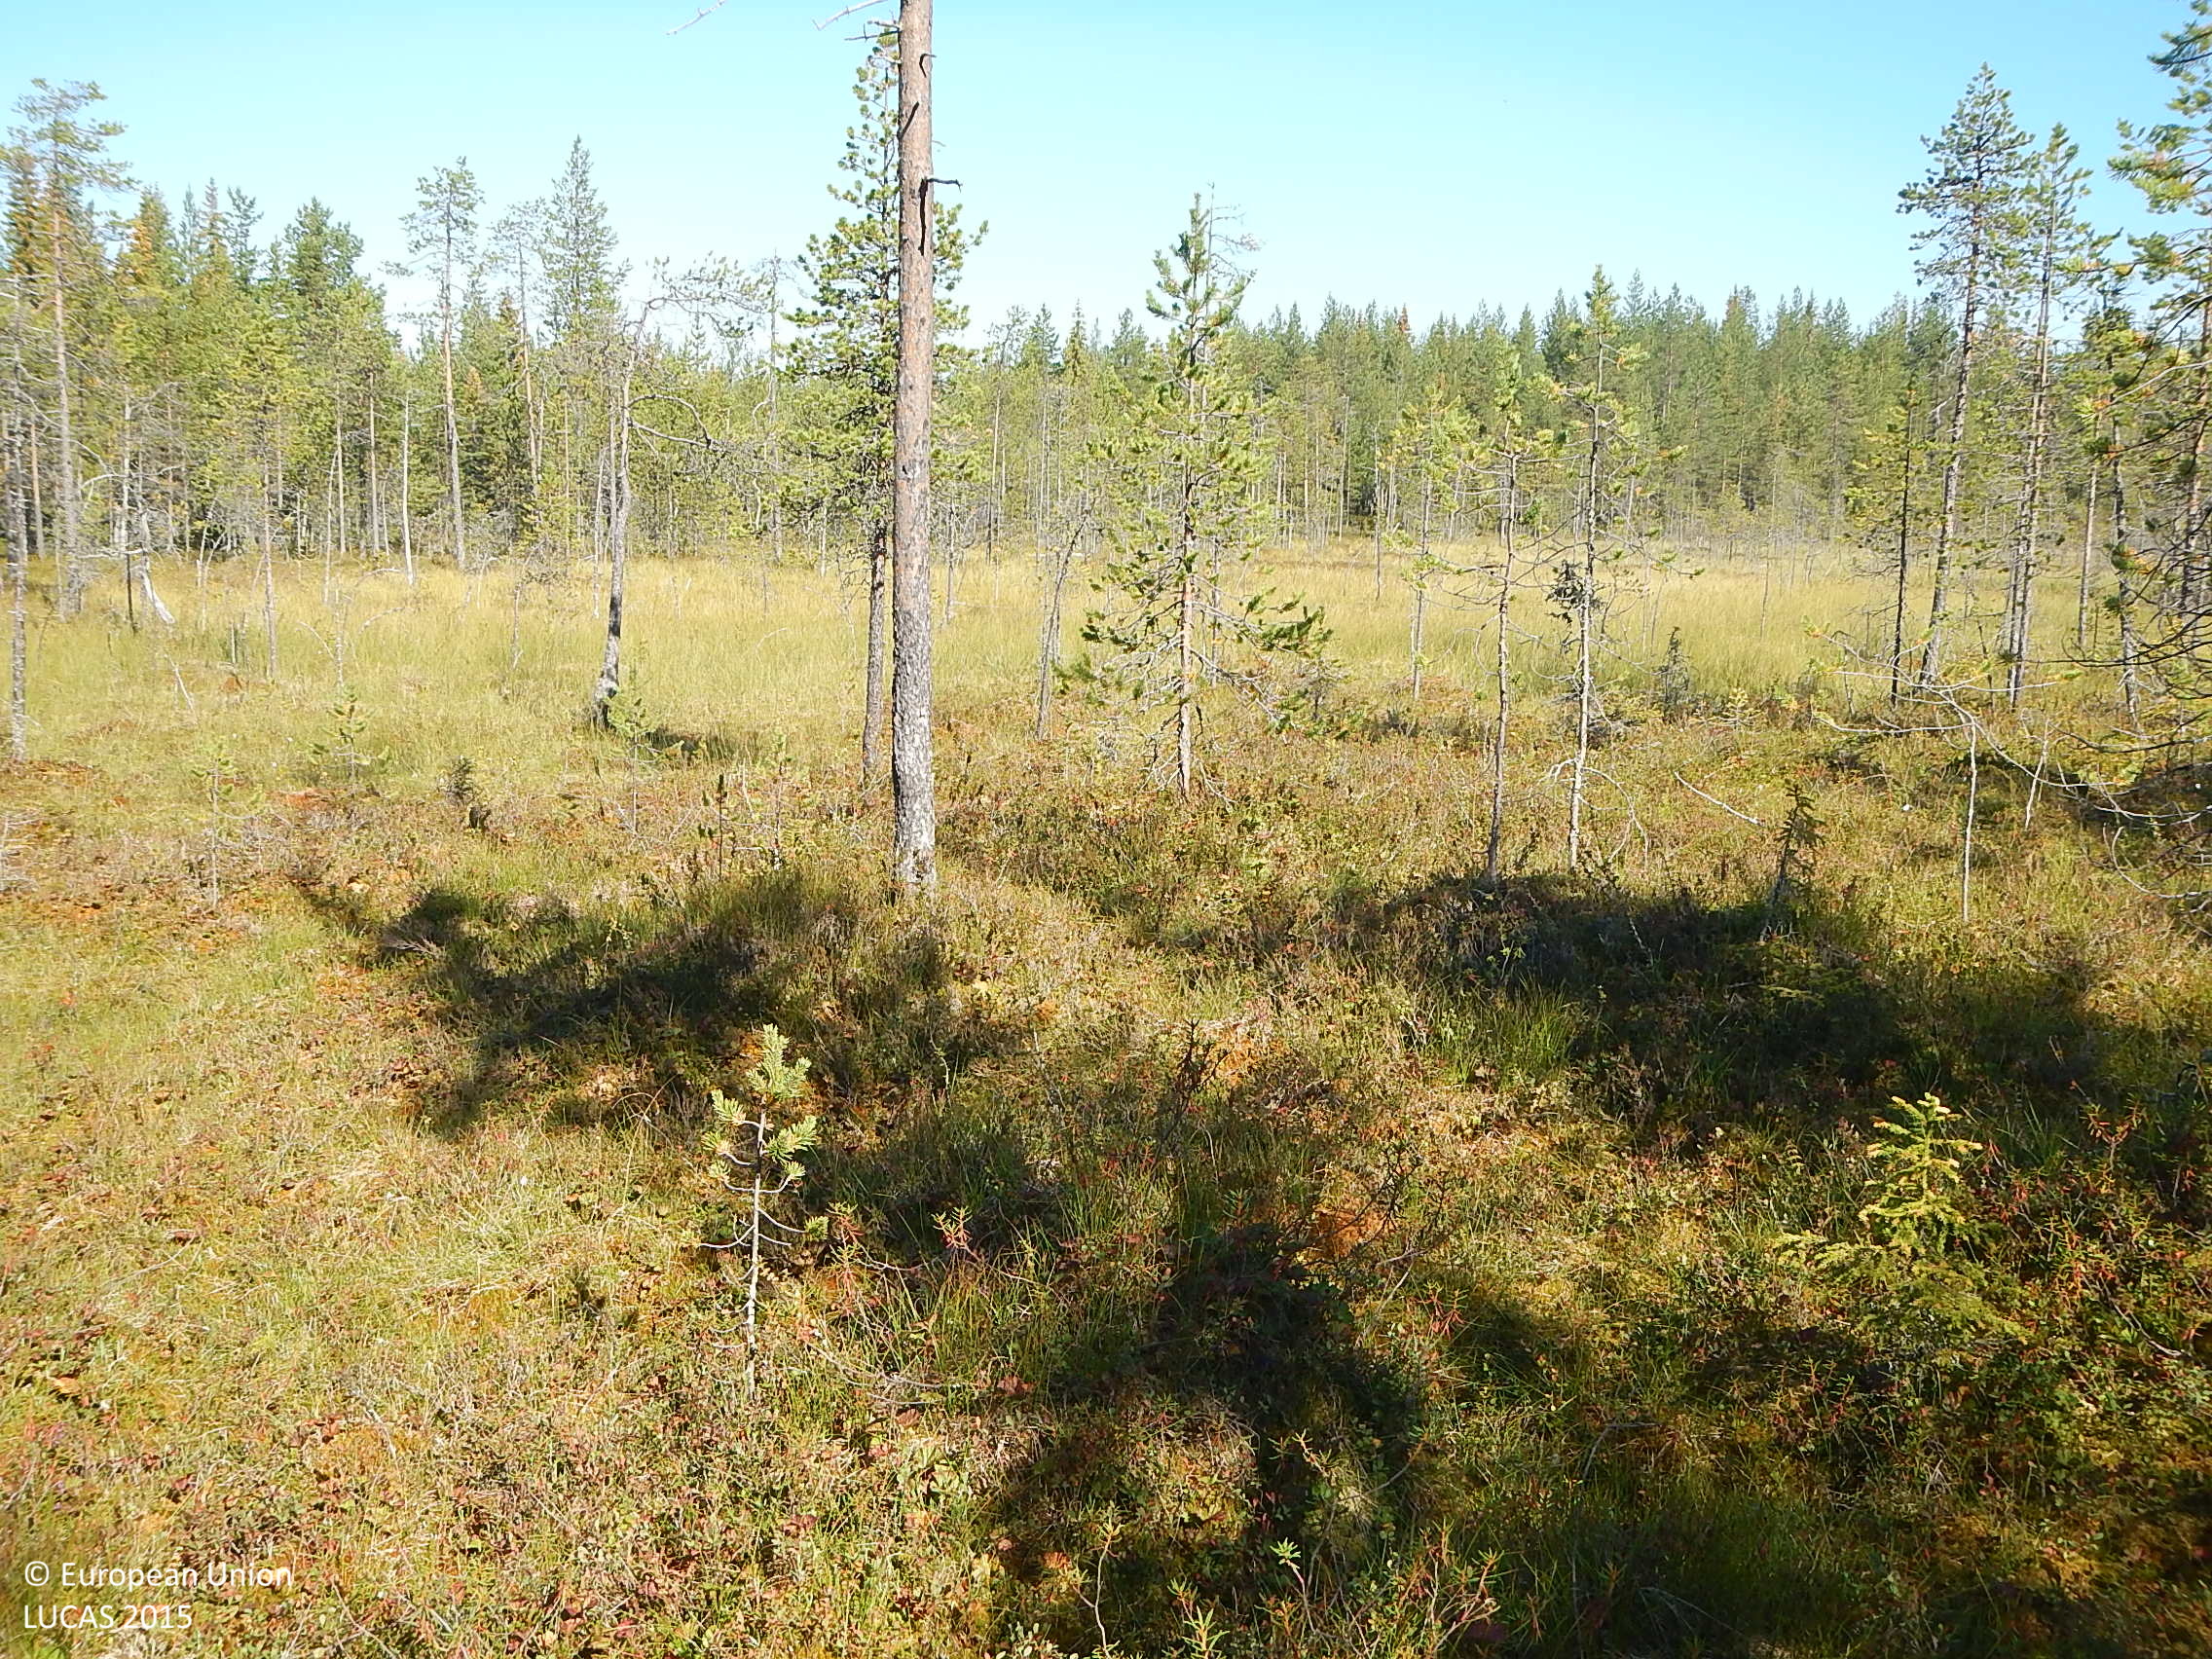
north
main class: Woodland
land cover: Other mixed woodland
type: boreal forest
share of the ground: 25 - 50 %
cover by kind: shrubs 40 %, lichens and mosses 20 %, coniferous forest trees 15 %, broadleaved forest trees 15 %, herbaceous plants 10 %
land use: Forestry
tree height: > 5 m
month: August
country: FI
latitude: 66.5257
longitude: 28.2007
